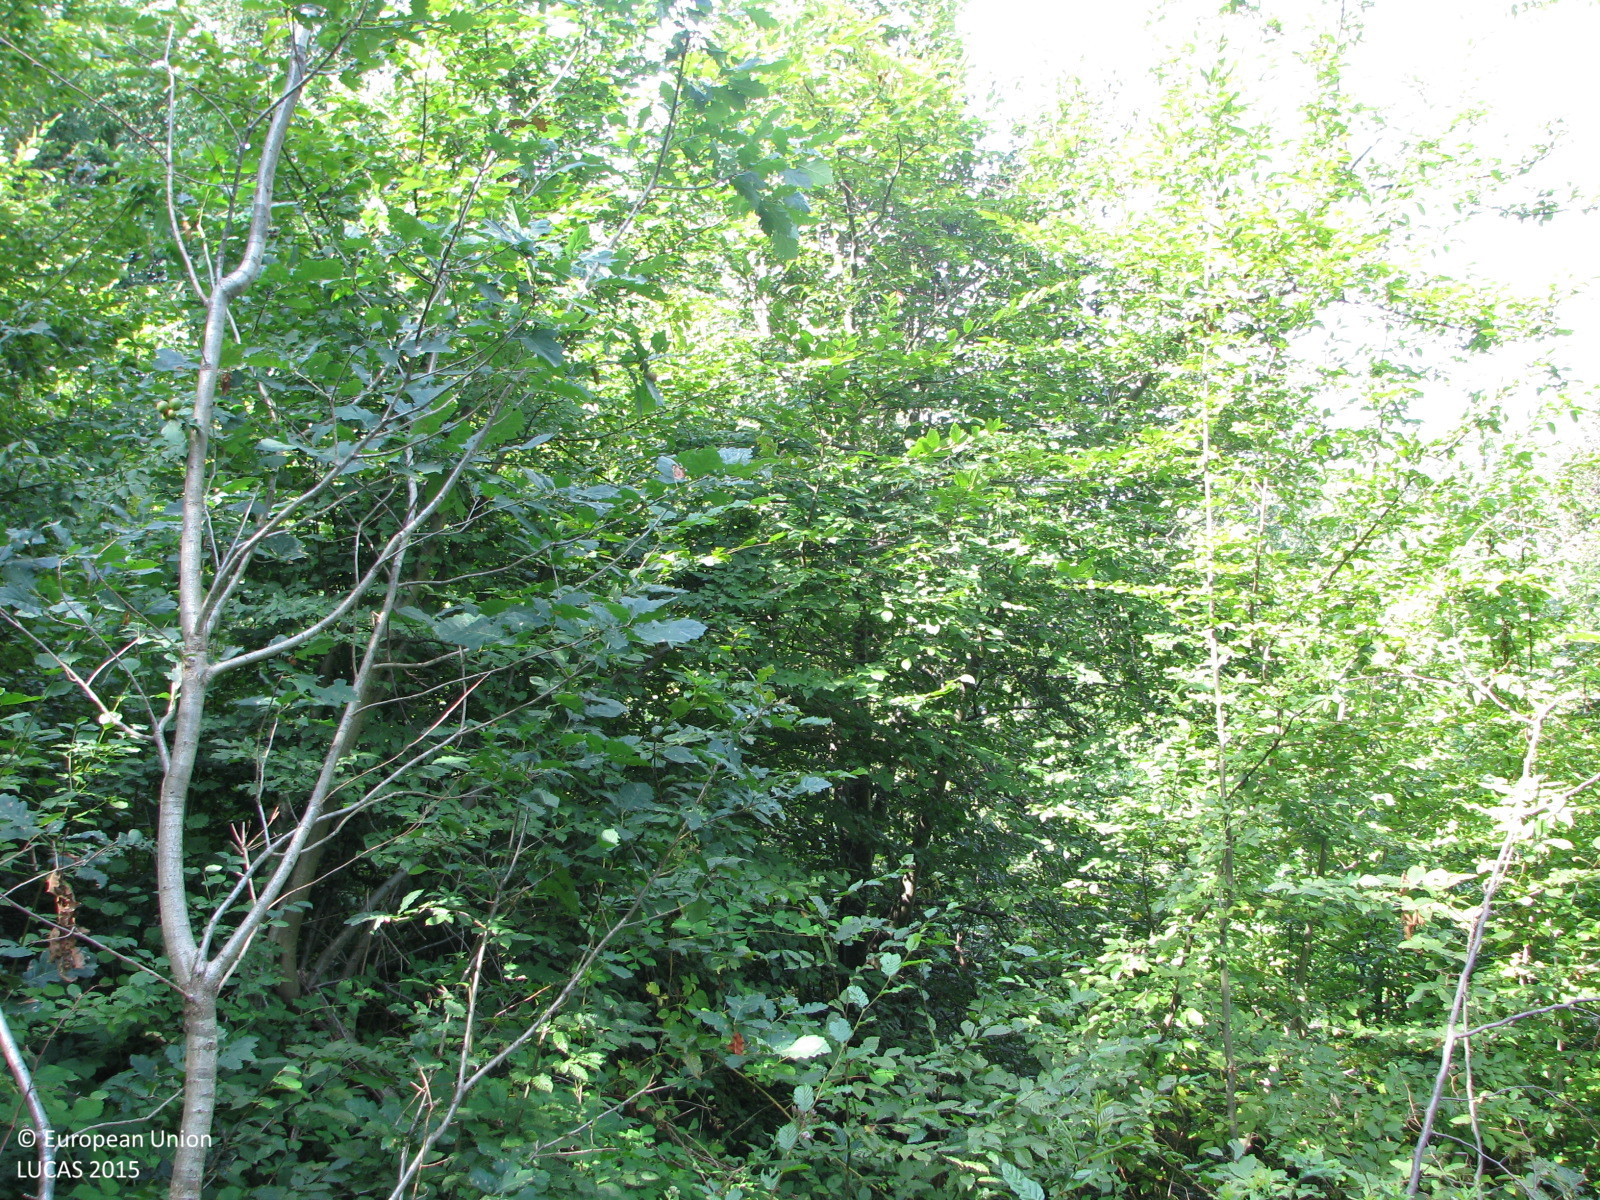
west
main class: Woodland
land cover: Broadleaved woodland
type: beech forest
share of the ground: > 75 %
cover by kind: broadleaved forest trees 80 %, shrubs 15 %, herbaceous plants 5 %
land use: Forestry
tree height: > 5 m
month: August
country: BG
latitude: 42.9241
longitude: 26.1765
